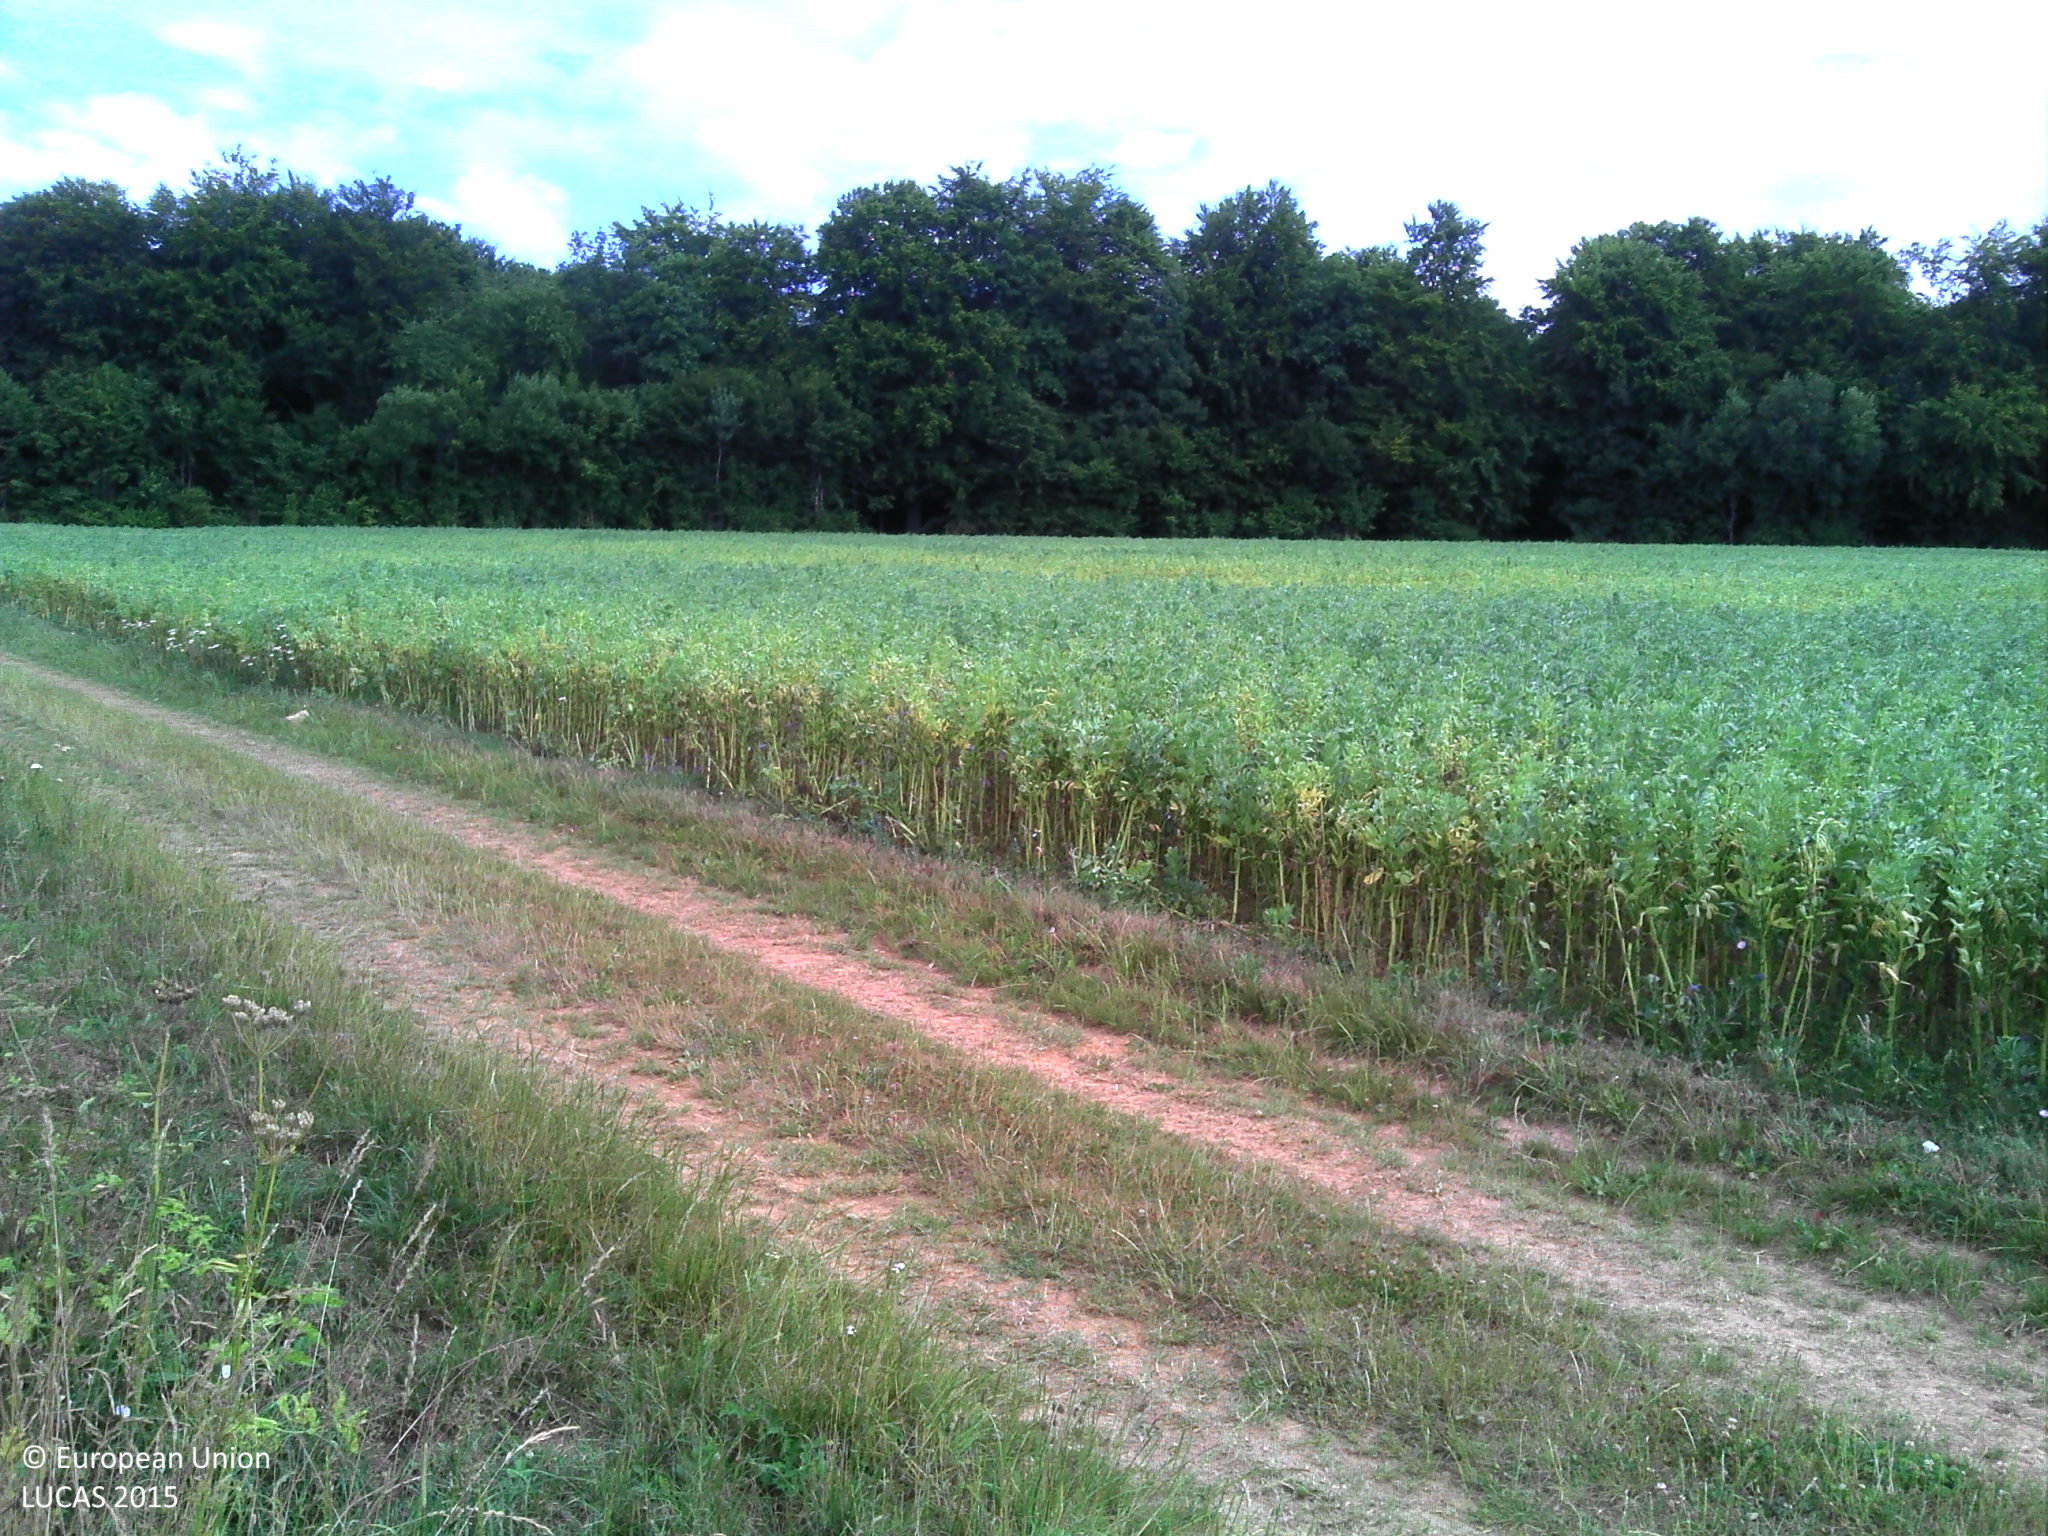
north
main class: Cropland
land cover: Rape and turnip rape
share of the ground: > 75 %
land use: Agriculture (excluding fallow land and kitchen gardens)
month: July
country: FR
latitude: 49.4454
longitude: 5.9304
